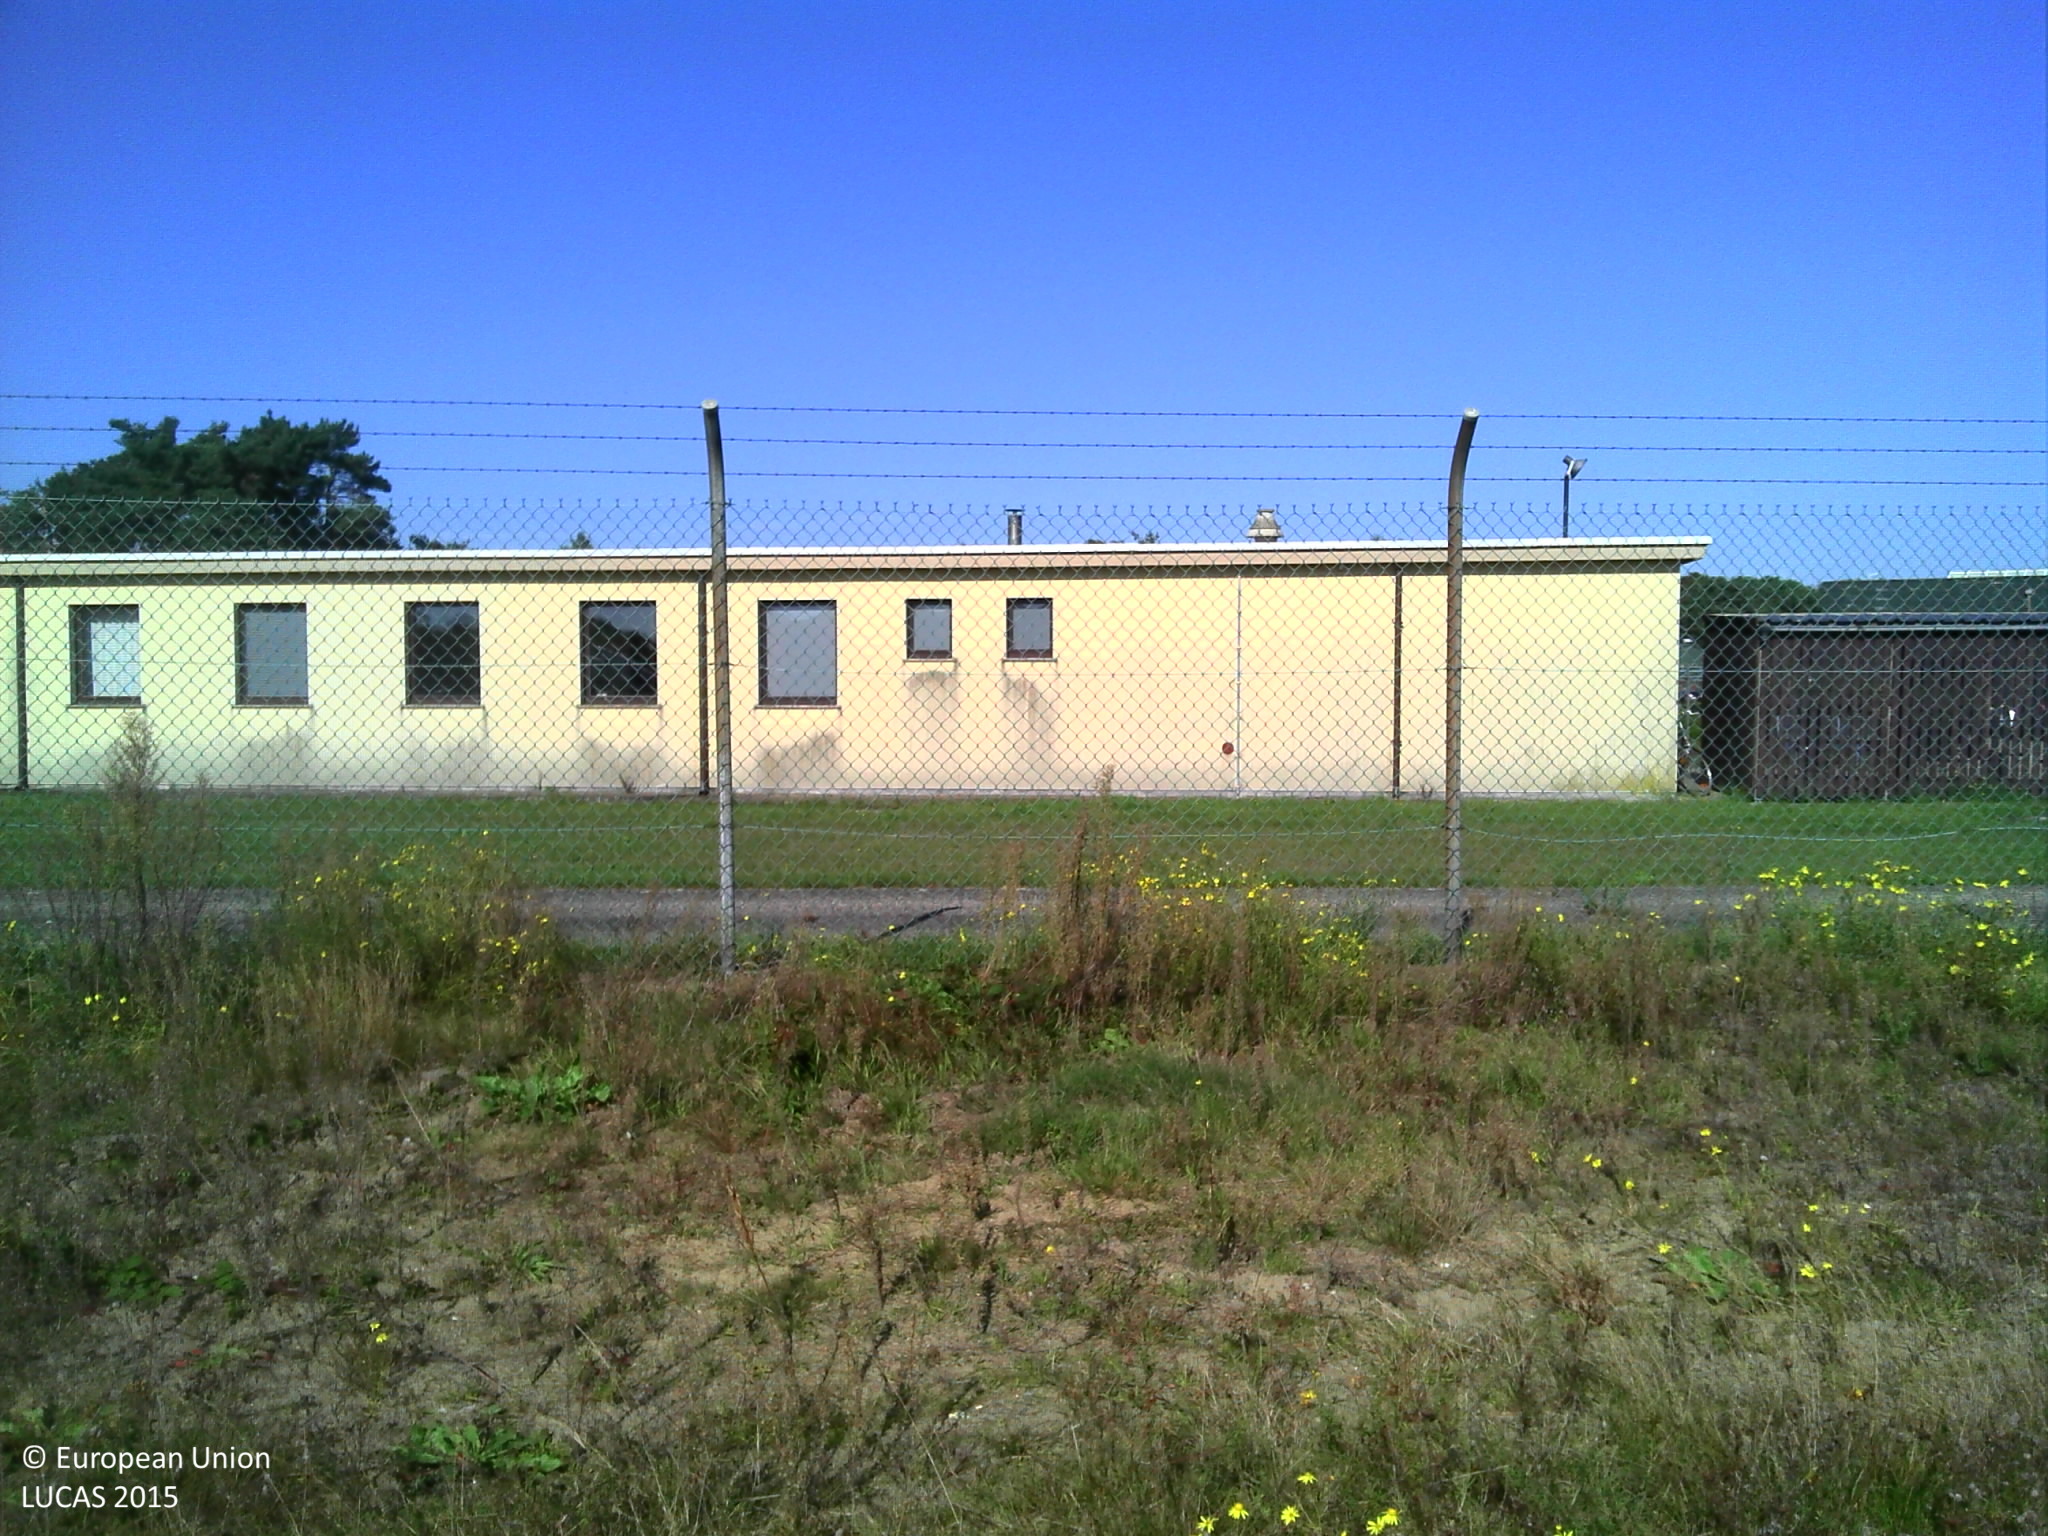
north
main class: Grassland
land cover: Spontaneously vegetated surfaces
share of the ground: > 75 %
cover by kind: herbaceous plants 80 %, unconsolidated bare surface 20 %
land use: Semi-natural and natural areas not in use
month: September
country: BE
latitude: 51.1803
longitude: 4.7464
